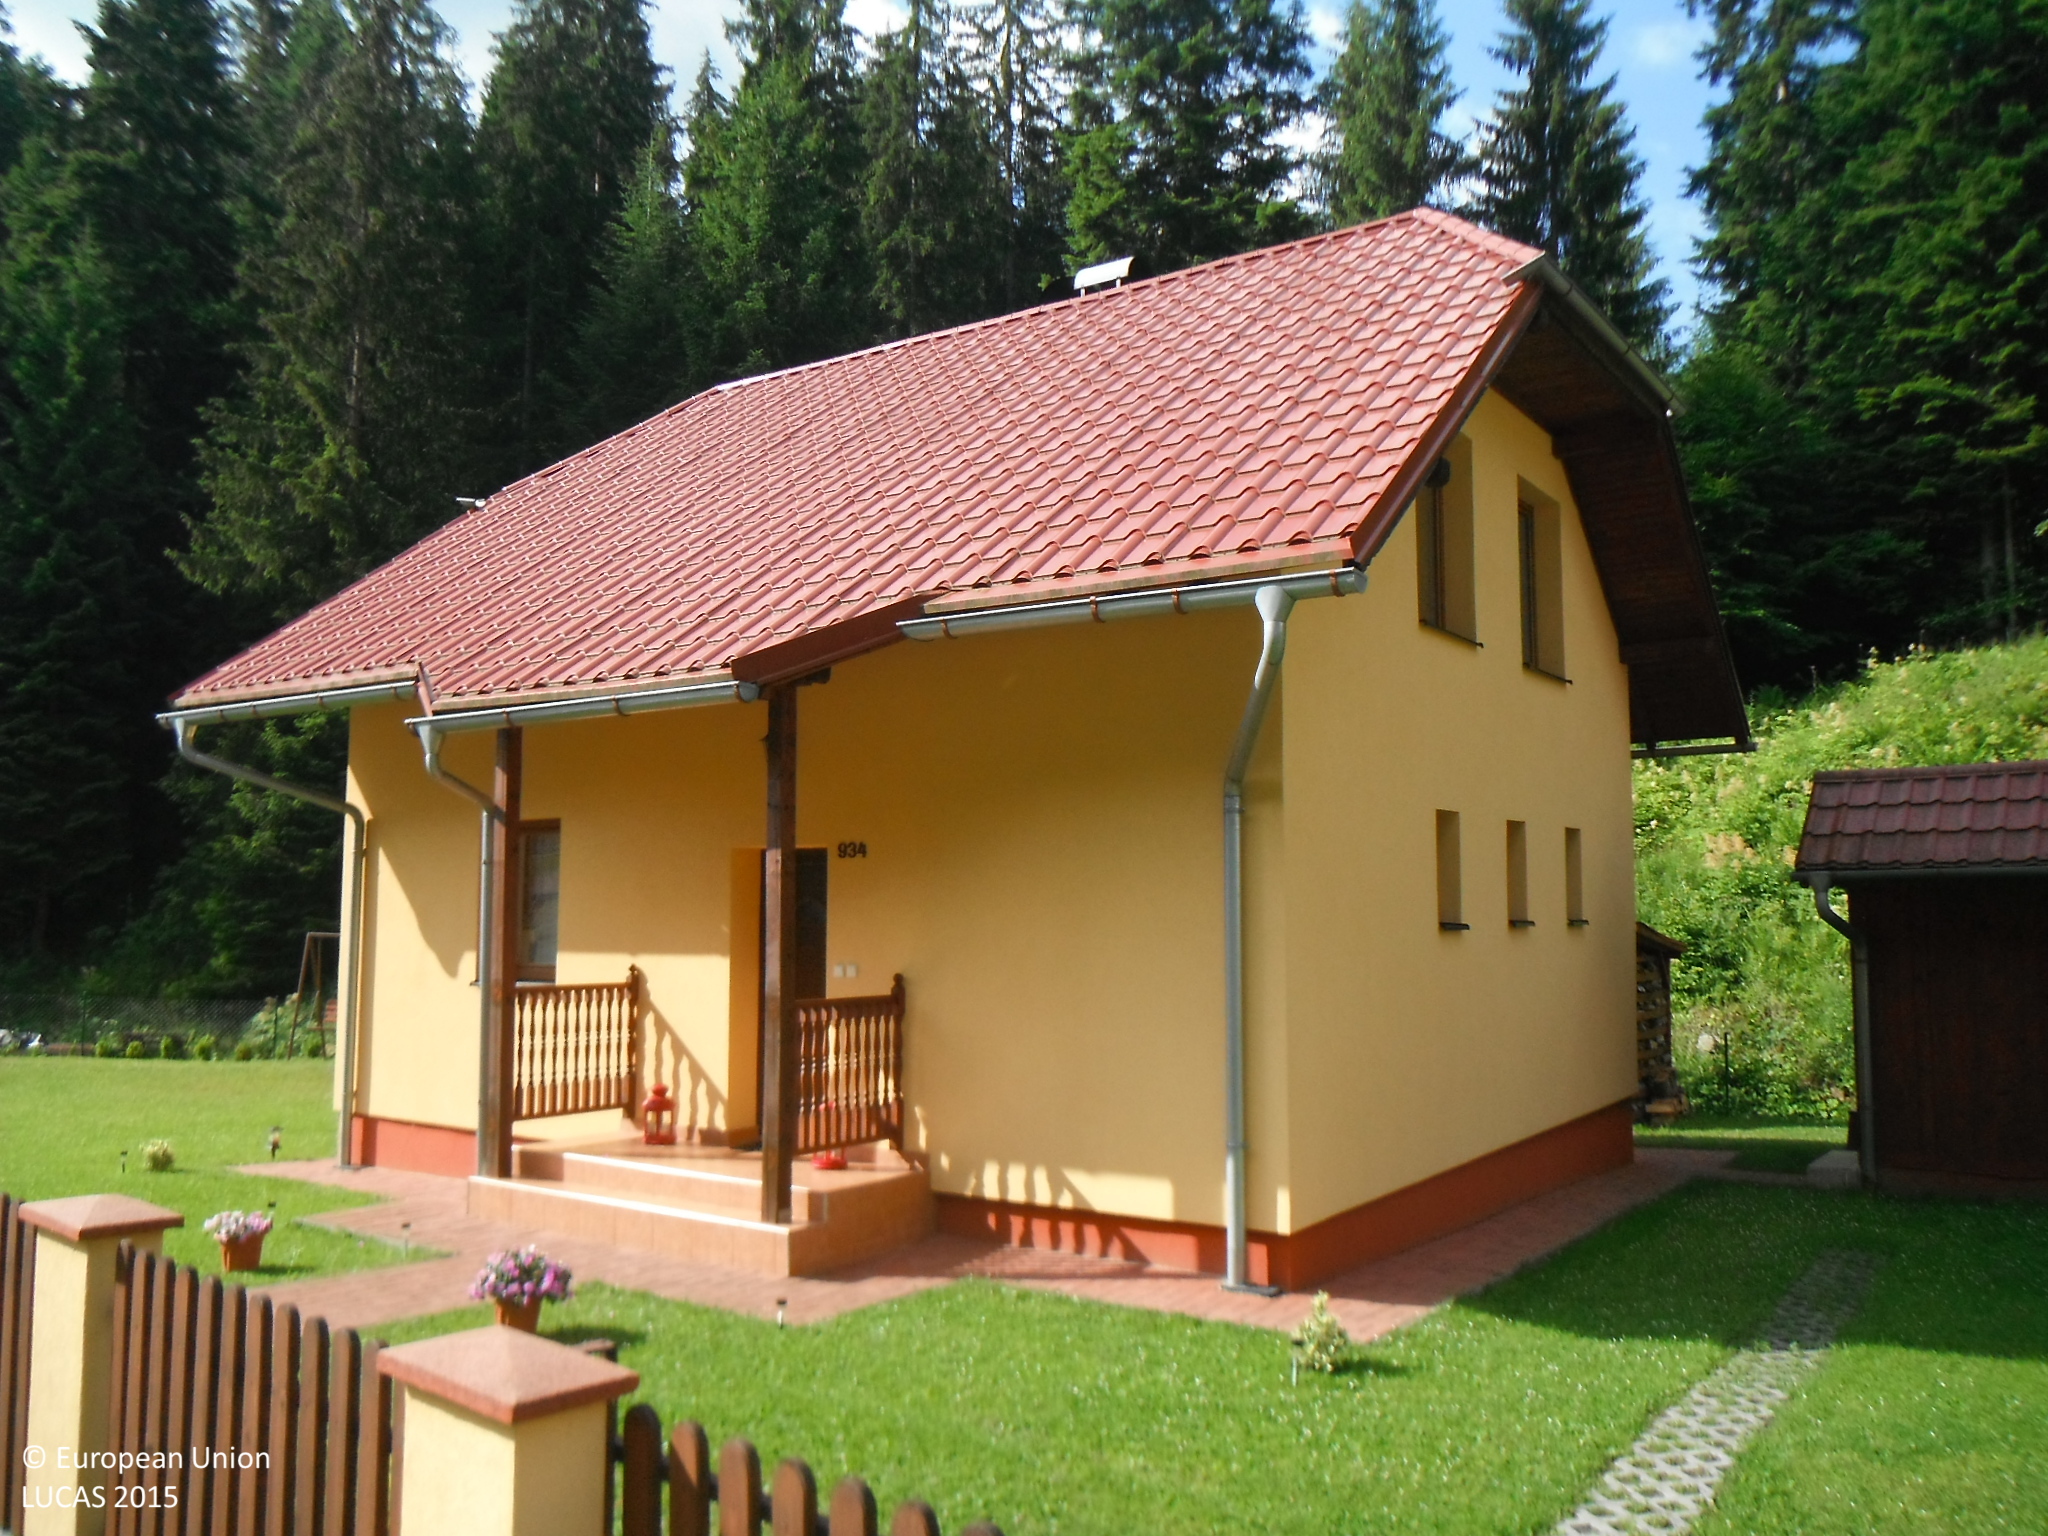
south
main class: Grassland
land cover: Grassland without tree/shrub cover
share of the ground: > 75 %
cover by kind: herbaceous plants 95 %
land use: Residential
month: July
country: SK
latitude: 49.4304
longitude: 18.5260
